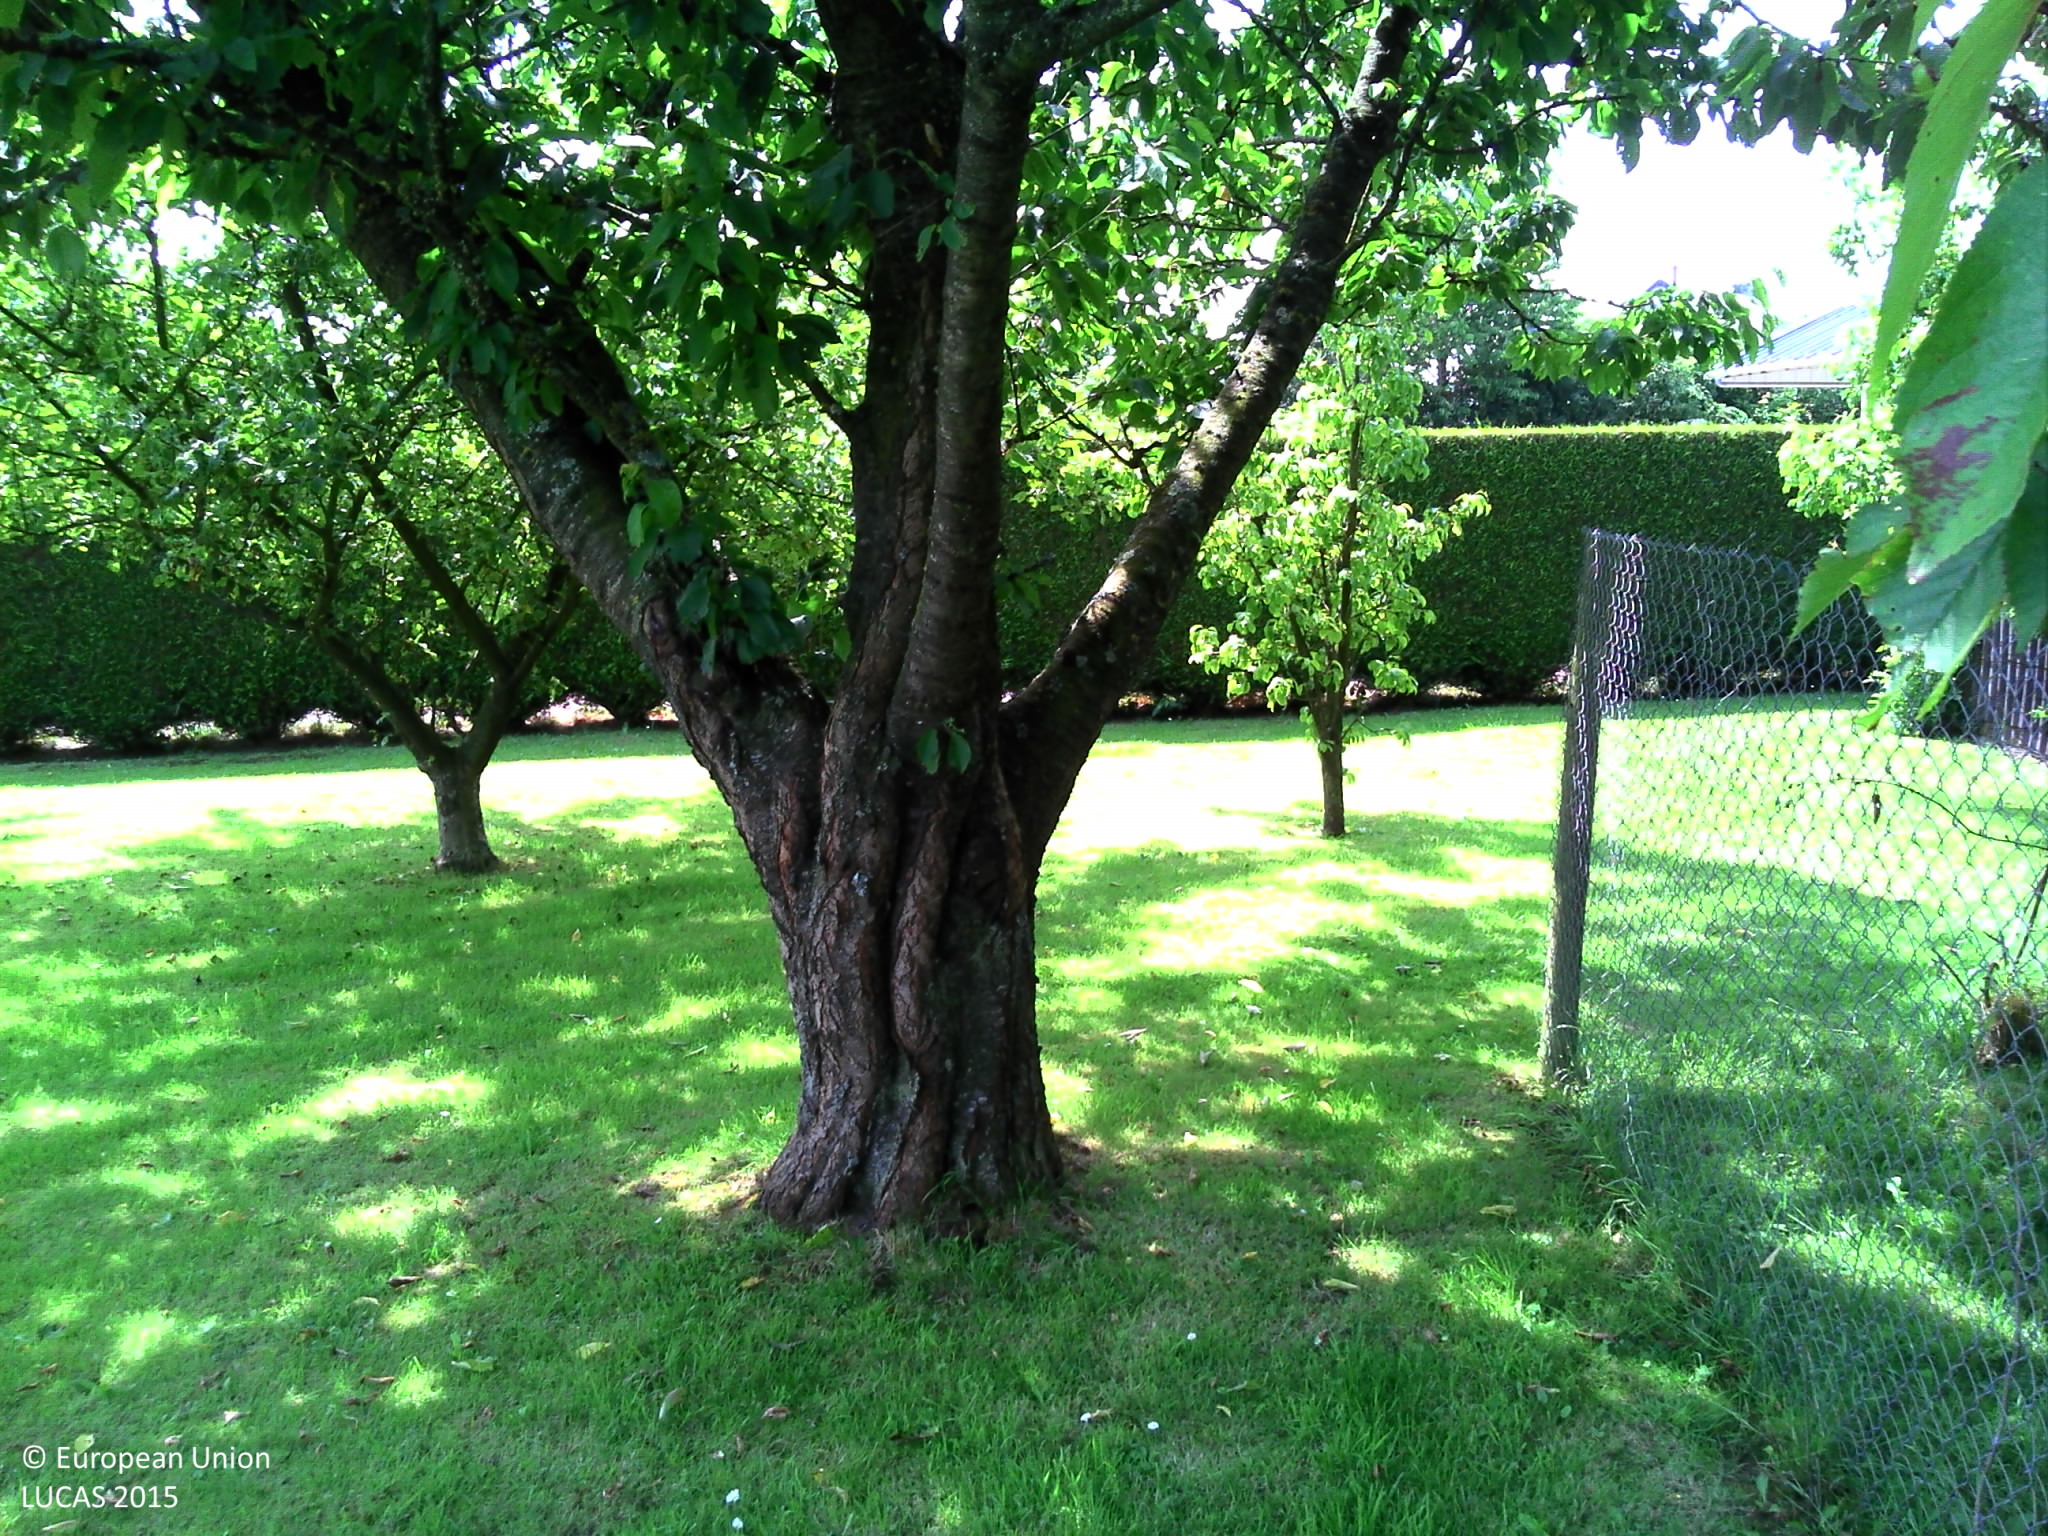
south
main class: Grassland
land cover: Grassland with sparse tree/shrub cover
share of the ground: > 75 %
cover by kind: herbaceous plants 95 %, broadleaved forest trees 5 %
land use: Residential
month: June
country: FR
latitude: 49.2163
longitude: -1.3454
